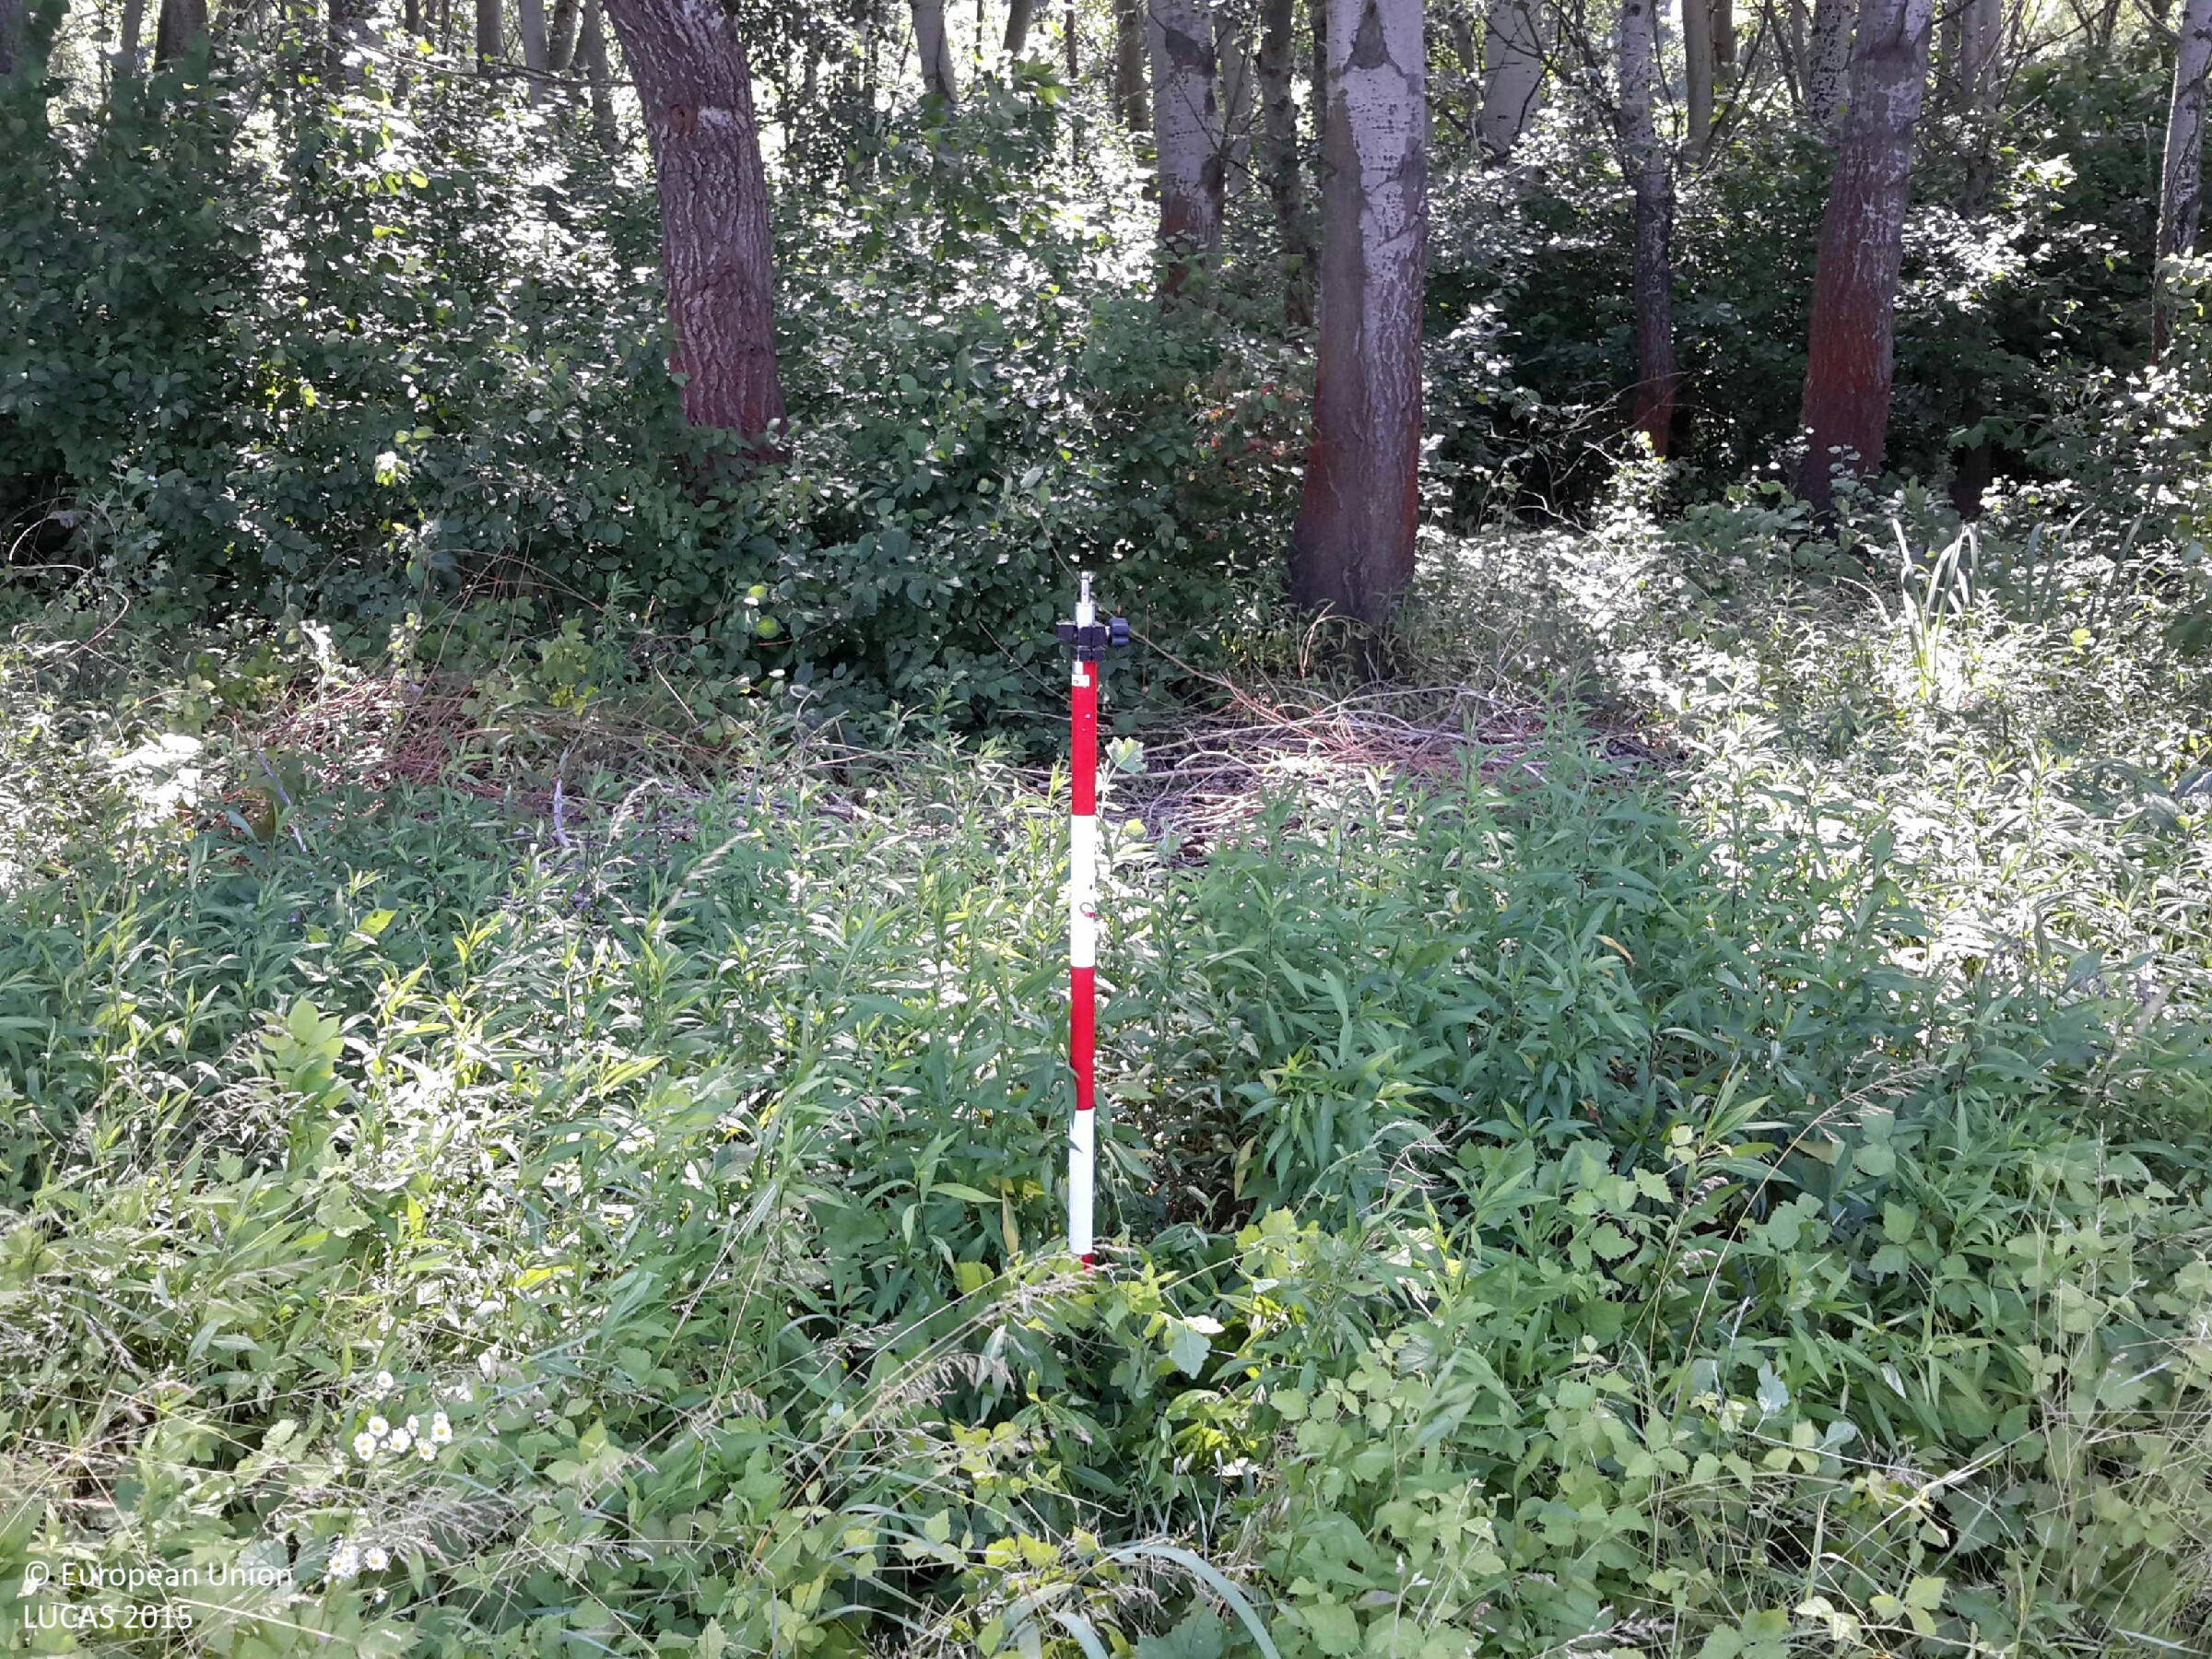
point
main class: Woodland
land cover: Broadleaved woodland
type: mire and swamp forests
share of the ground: > 75 %
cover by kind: broadleaved forest trees 80 %, herbaceous plants 15 %, shrubs 5 %
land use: Forestry
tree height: > 5 m
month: June
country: HU
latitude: 47.6924
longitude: 17.5635
